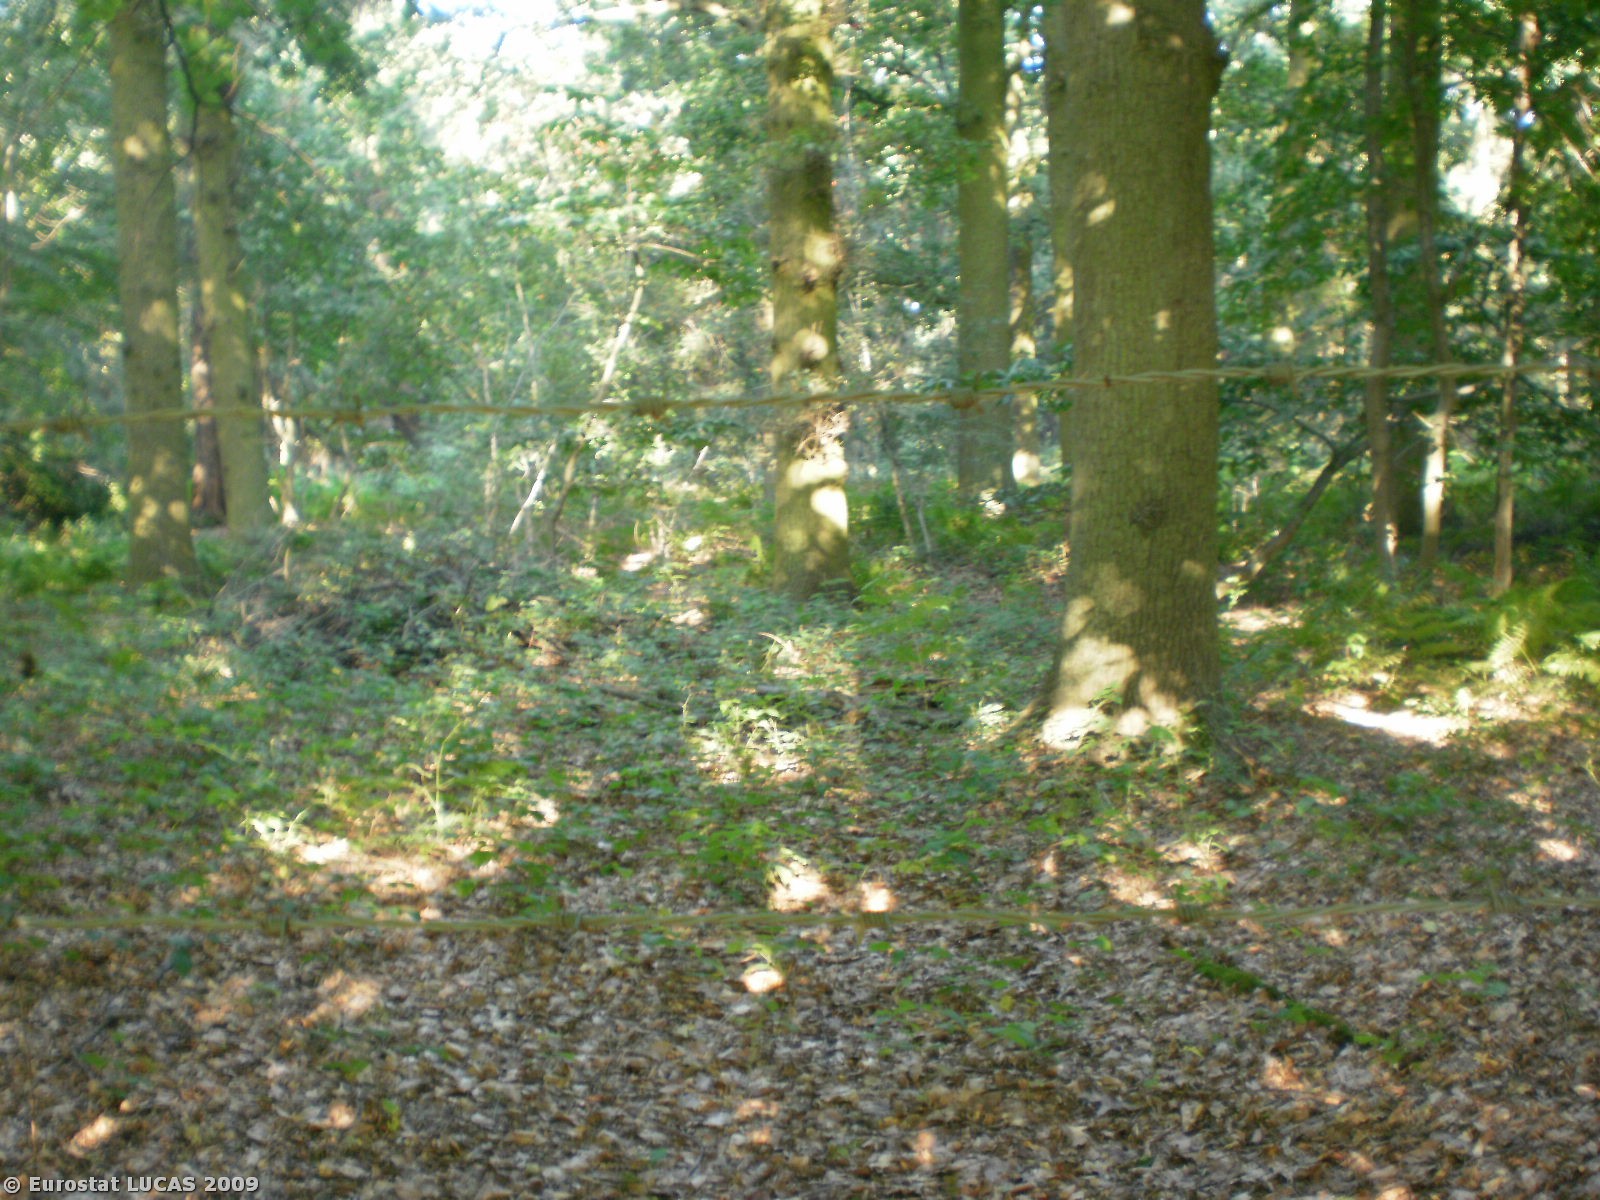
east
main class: Woodland
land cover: Broadleaved woodland
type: acidophilous oak and oak-birch forest
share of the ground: > 75 %
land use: Amenities, museums, leisure
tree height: > 5 m
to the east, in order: Broadleaved woodland; Grassland with sparse tree/shrub cover
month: June
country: BE
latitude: 50.8897
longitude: 5.5486
